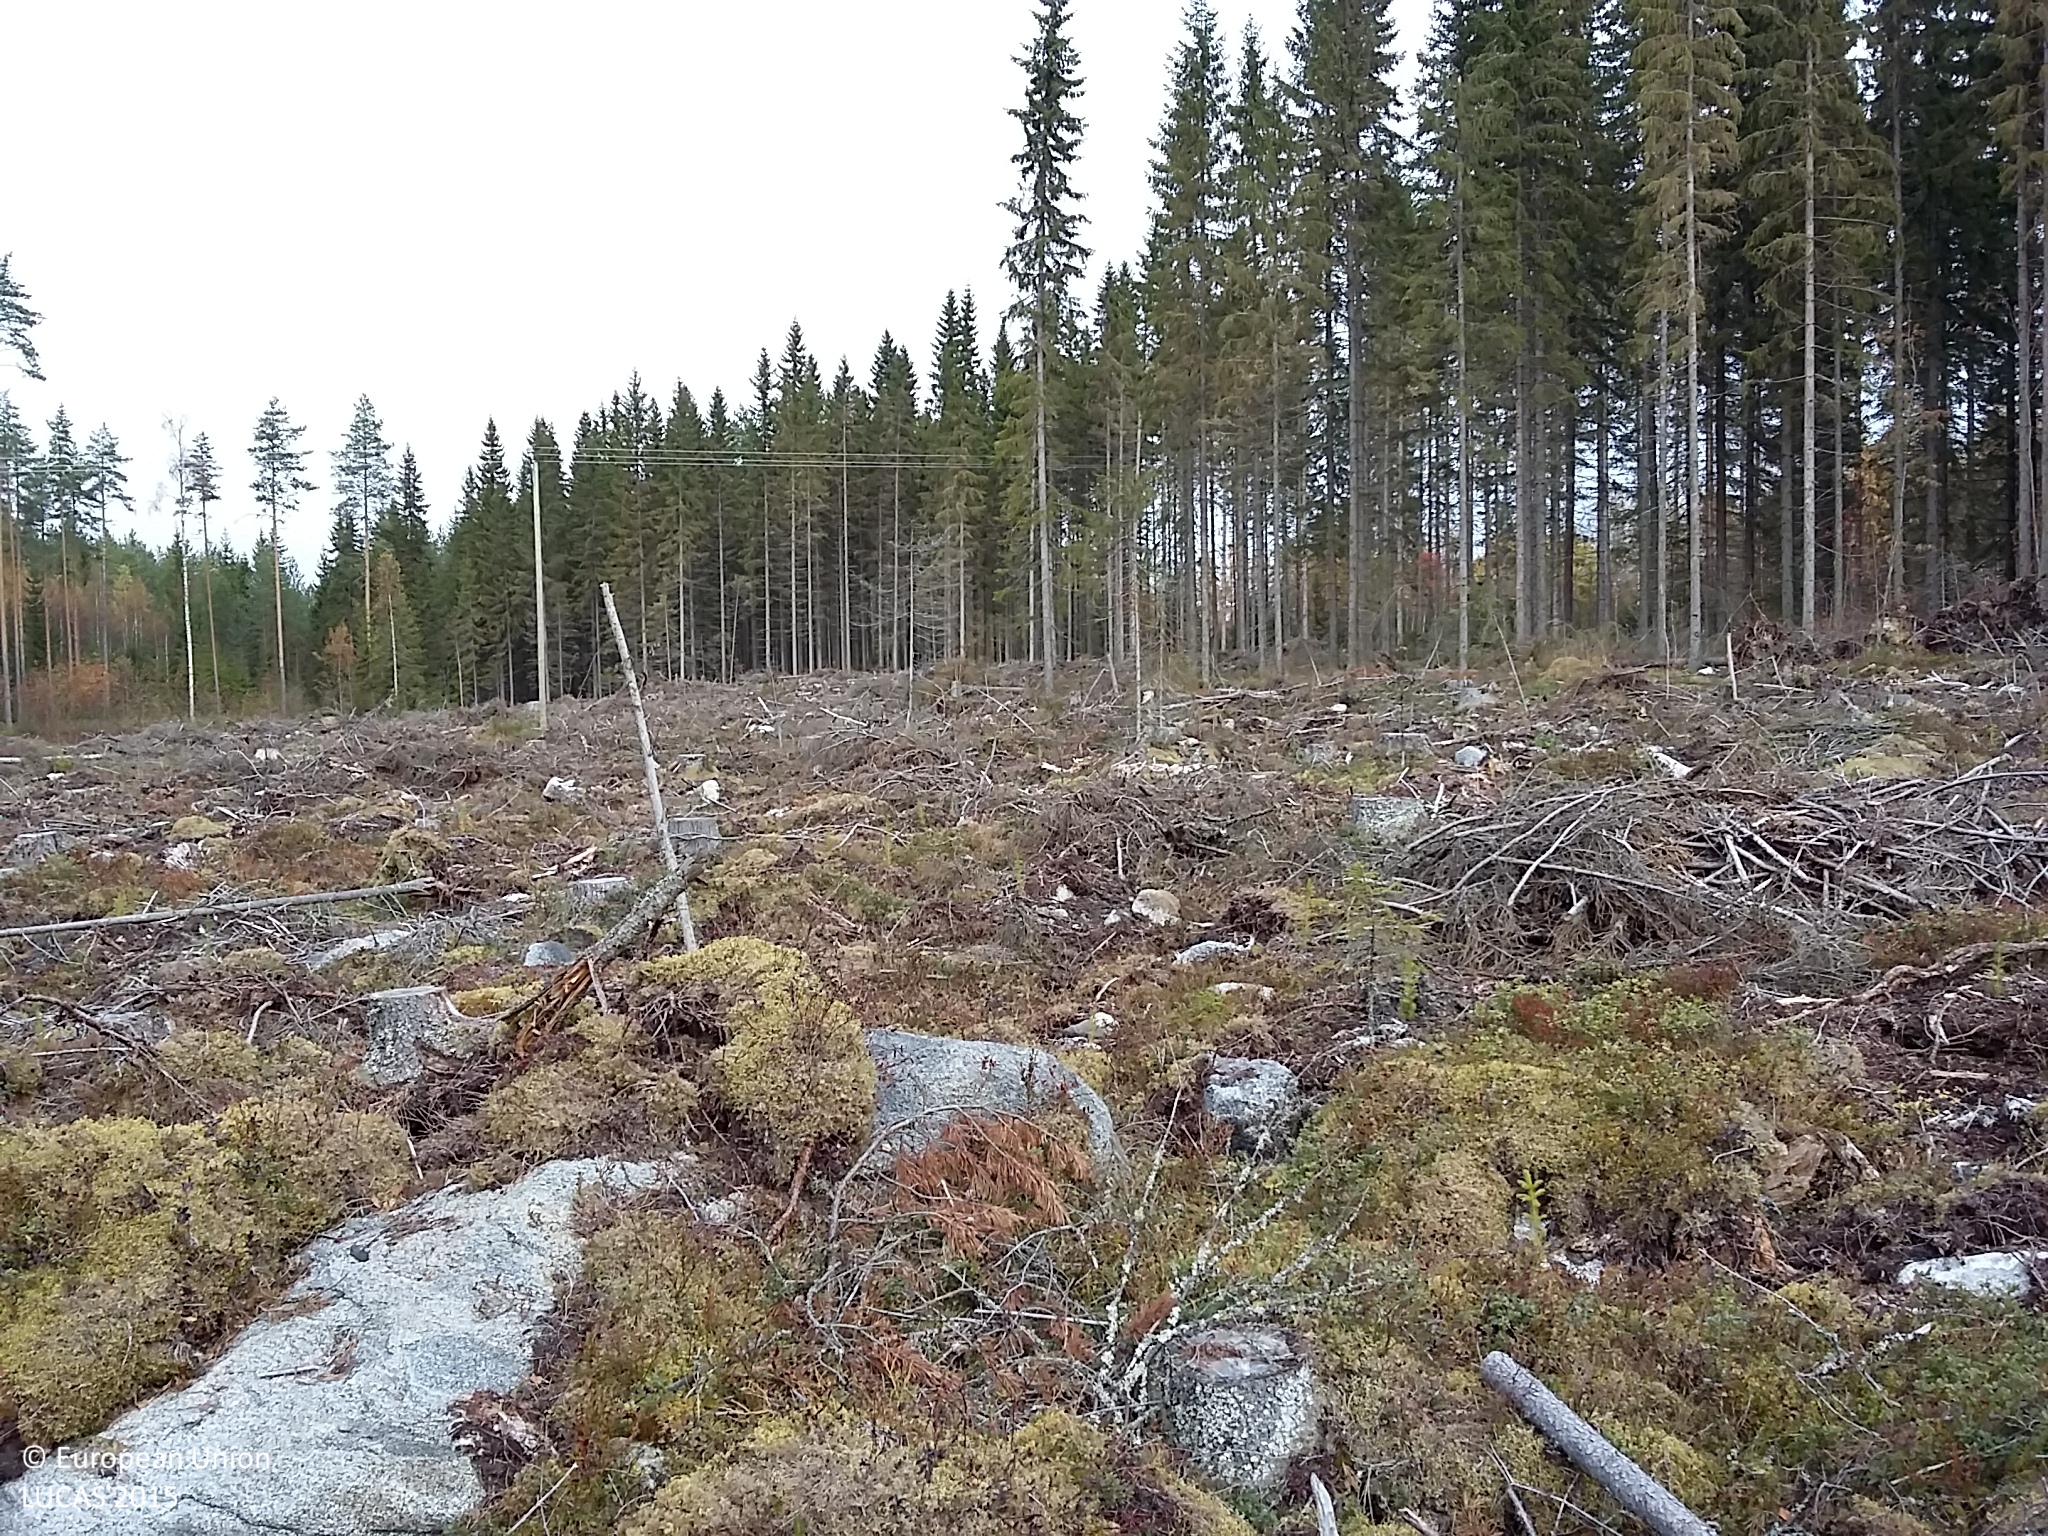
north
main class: Shrubland
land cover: Shrubland with sparse tree cover
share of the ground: 10 - 25 %
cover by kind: lichens and mosses 35 %, unconsolidated bare surface 25 %, shrubs 15 %, coniferous forest trees 5 %, herbaceous plants 5 %, consolidated bare surface 5 %
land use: Forestry
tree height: < 5 m
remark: Clear cut
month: October
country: FI
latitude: 62.5132
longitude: 26.2701
